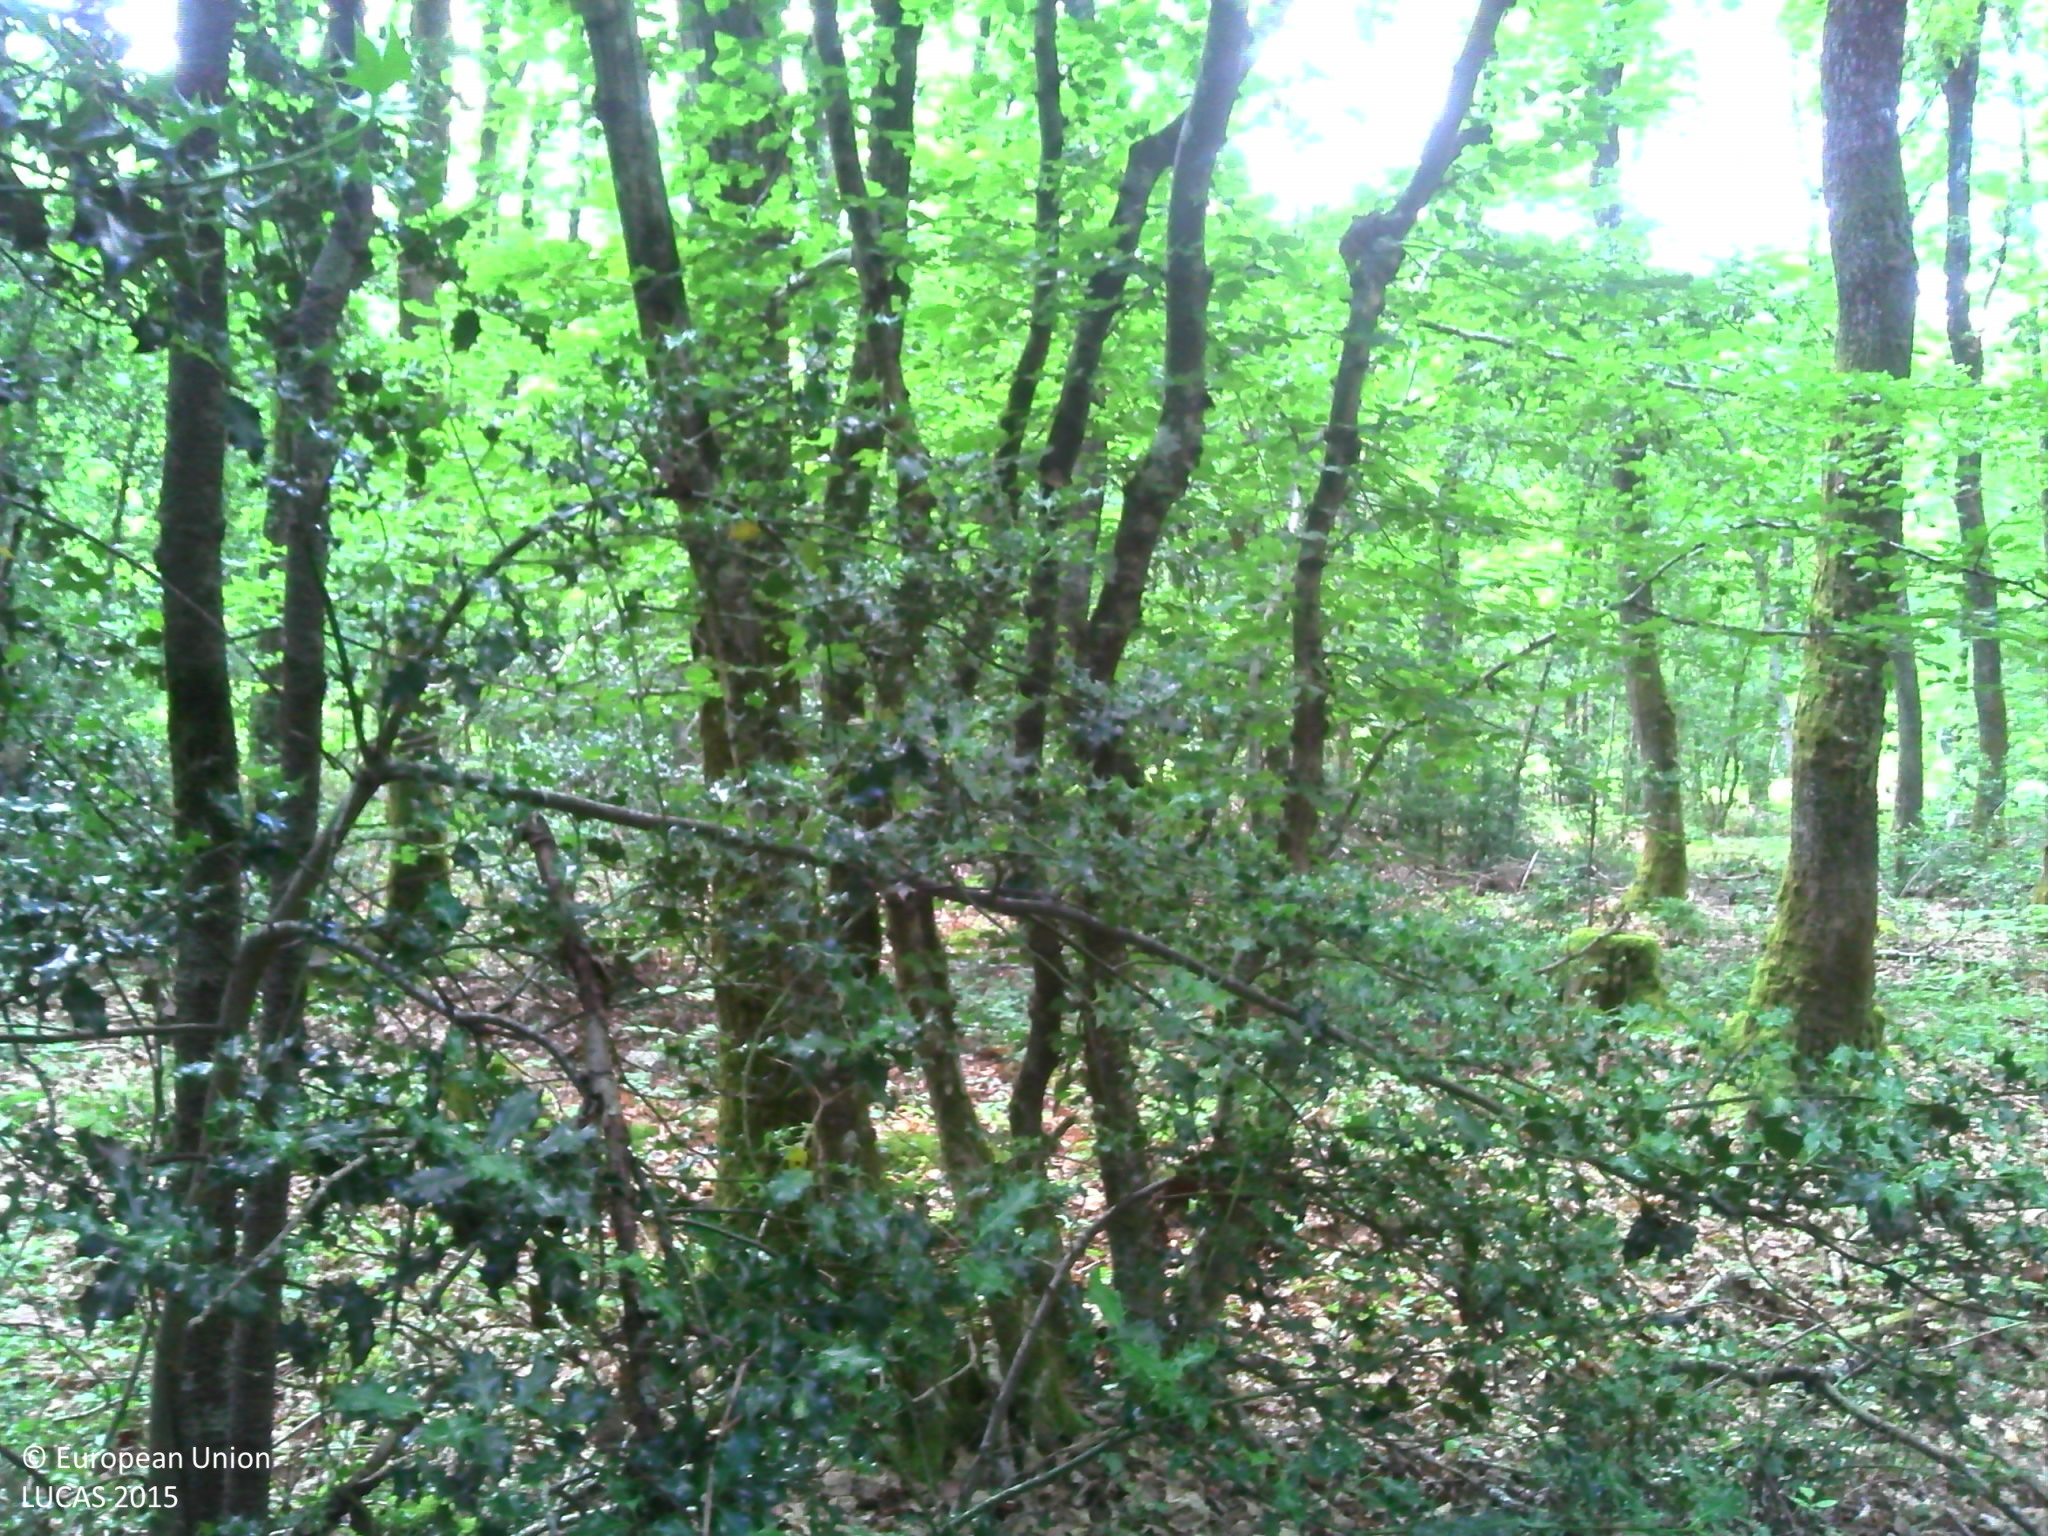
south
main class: Woodland
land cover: Broadleaved woodland
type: mesophytic deciduous forest
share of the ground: > 75 %
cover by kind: broadleaved forest trees 100 %
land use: Forestry
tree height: > 5 m
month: June
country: FR
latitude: 47.3221
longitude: 2.5704
